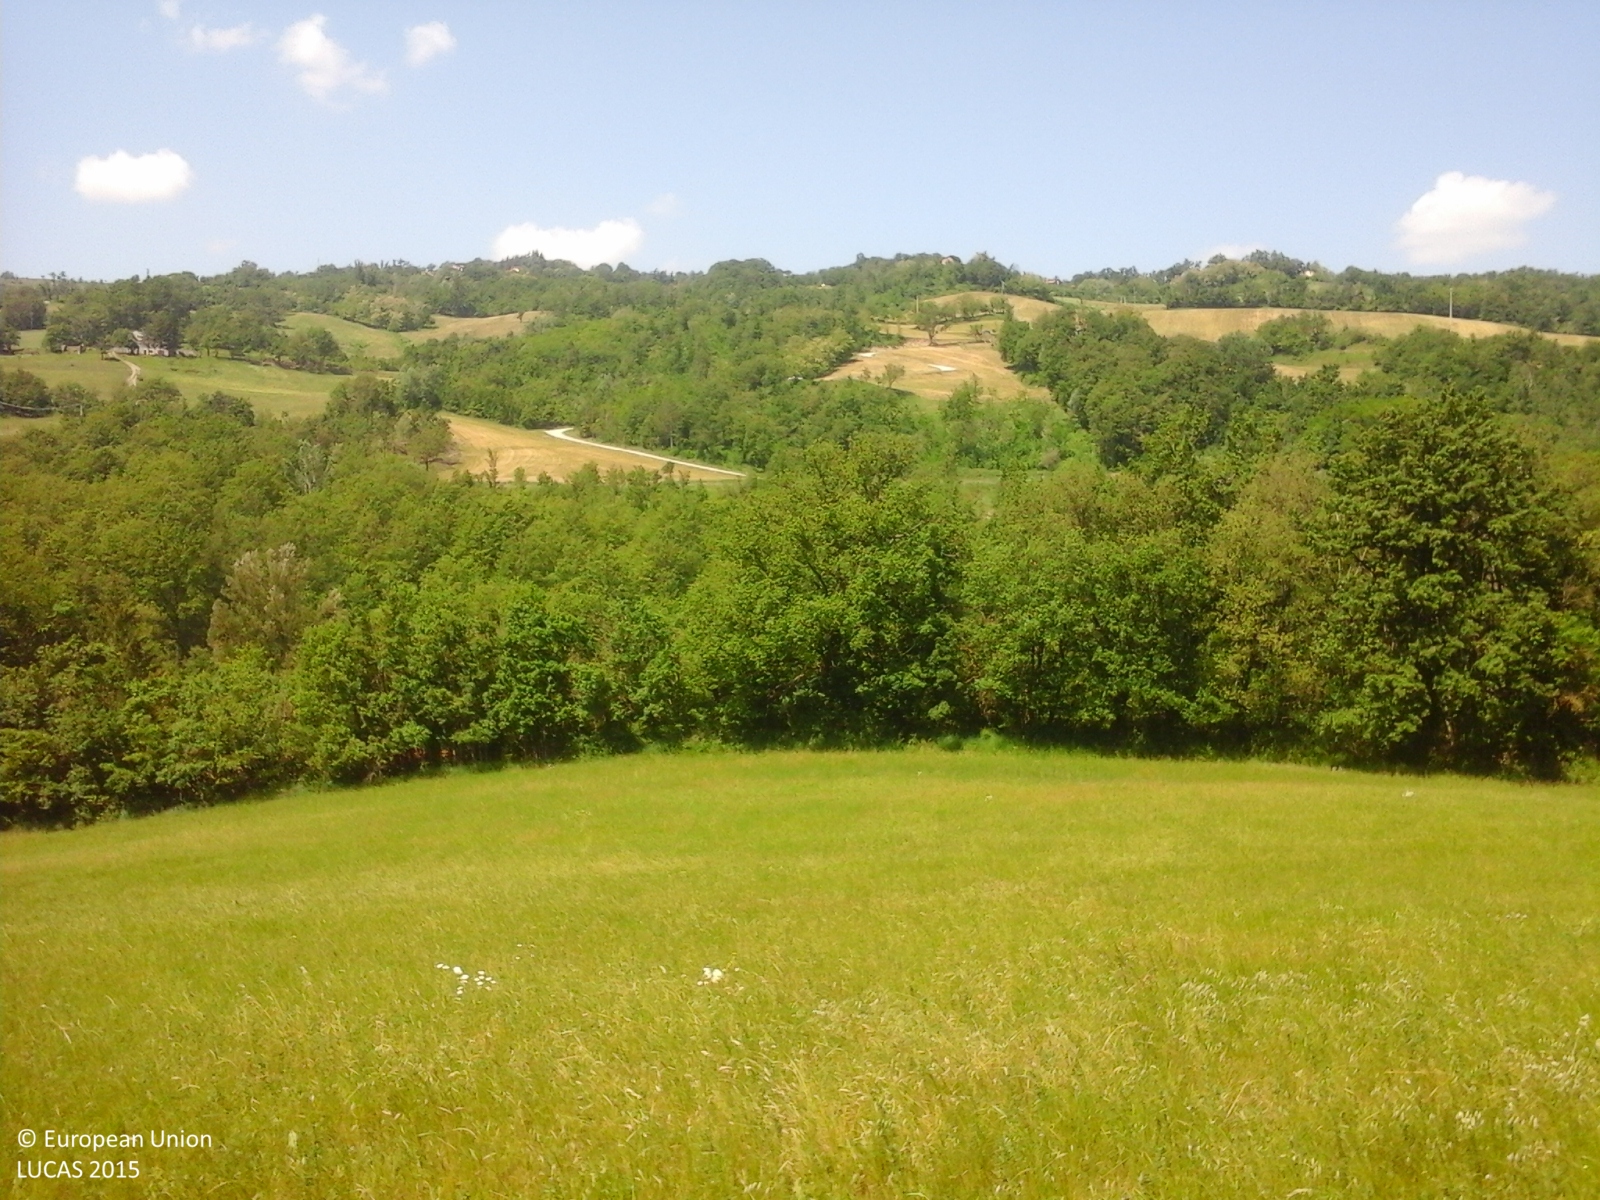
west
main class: Grassland
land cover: Grassland without tree/shrub cover
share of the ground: > 75 %
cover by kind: herbaceous plants 100 %
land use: Agriculture (excluding fallow land and kitchen gardens)
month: May
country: IT
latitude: 44.2189
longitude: 11.0614
